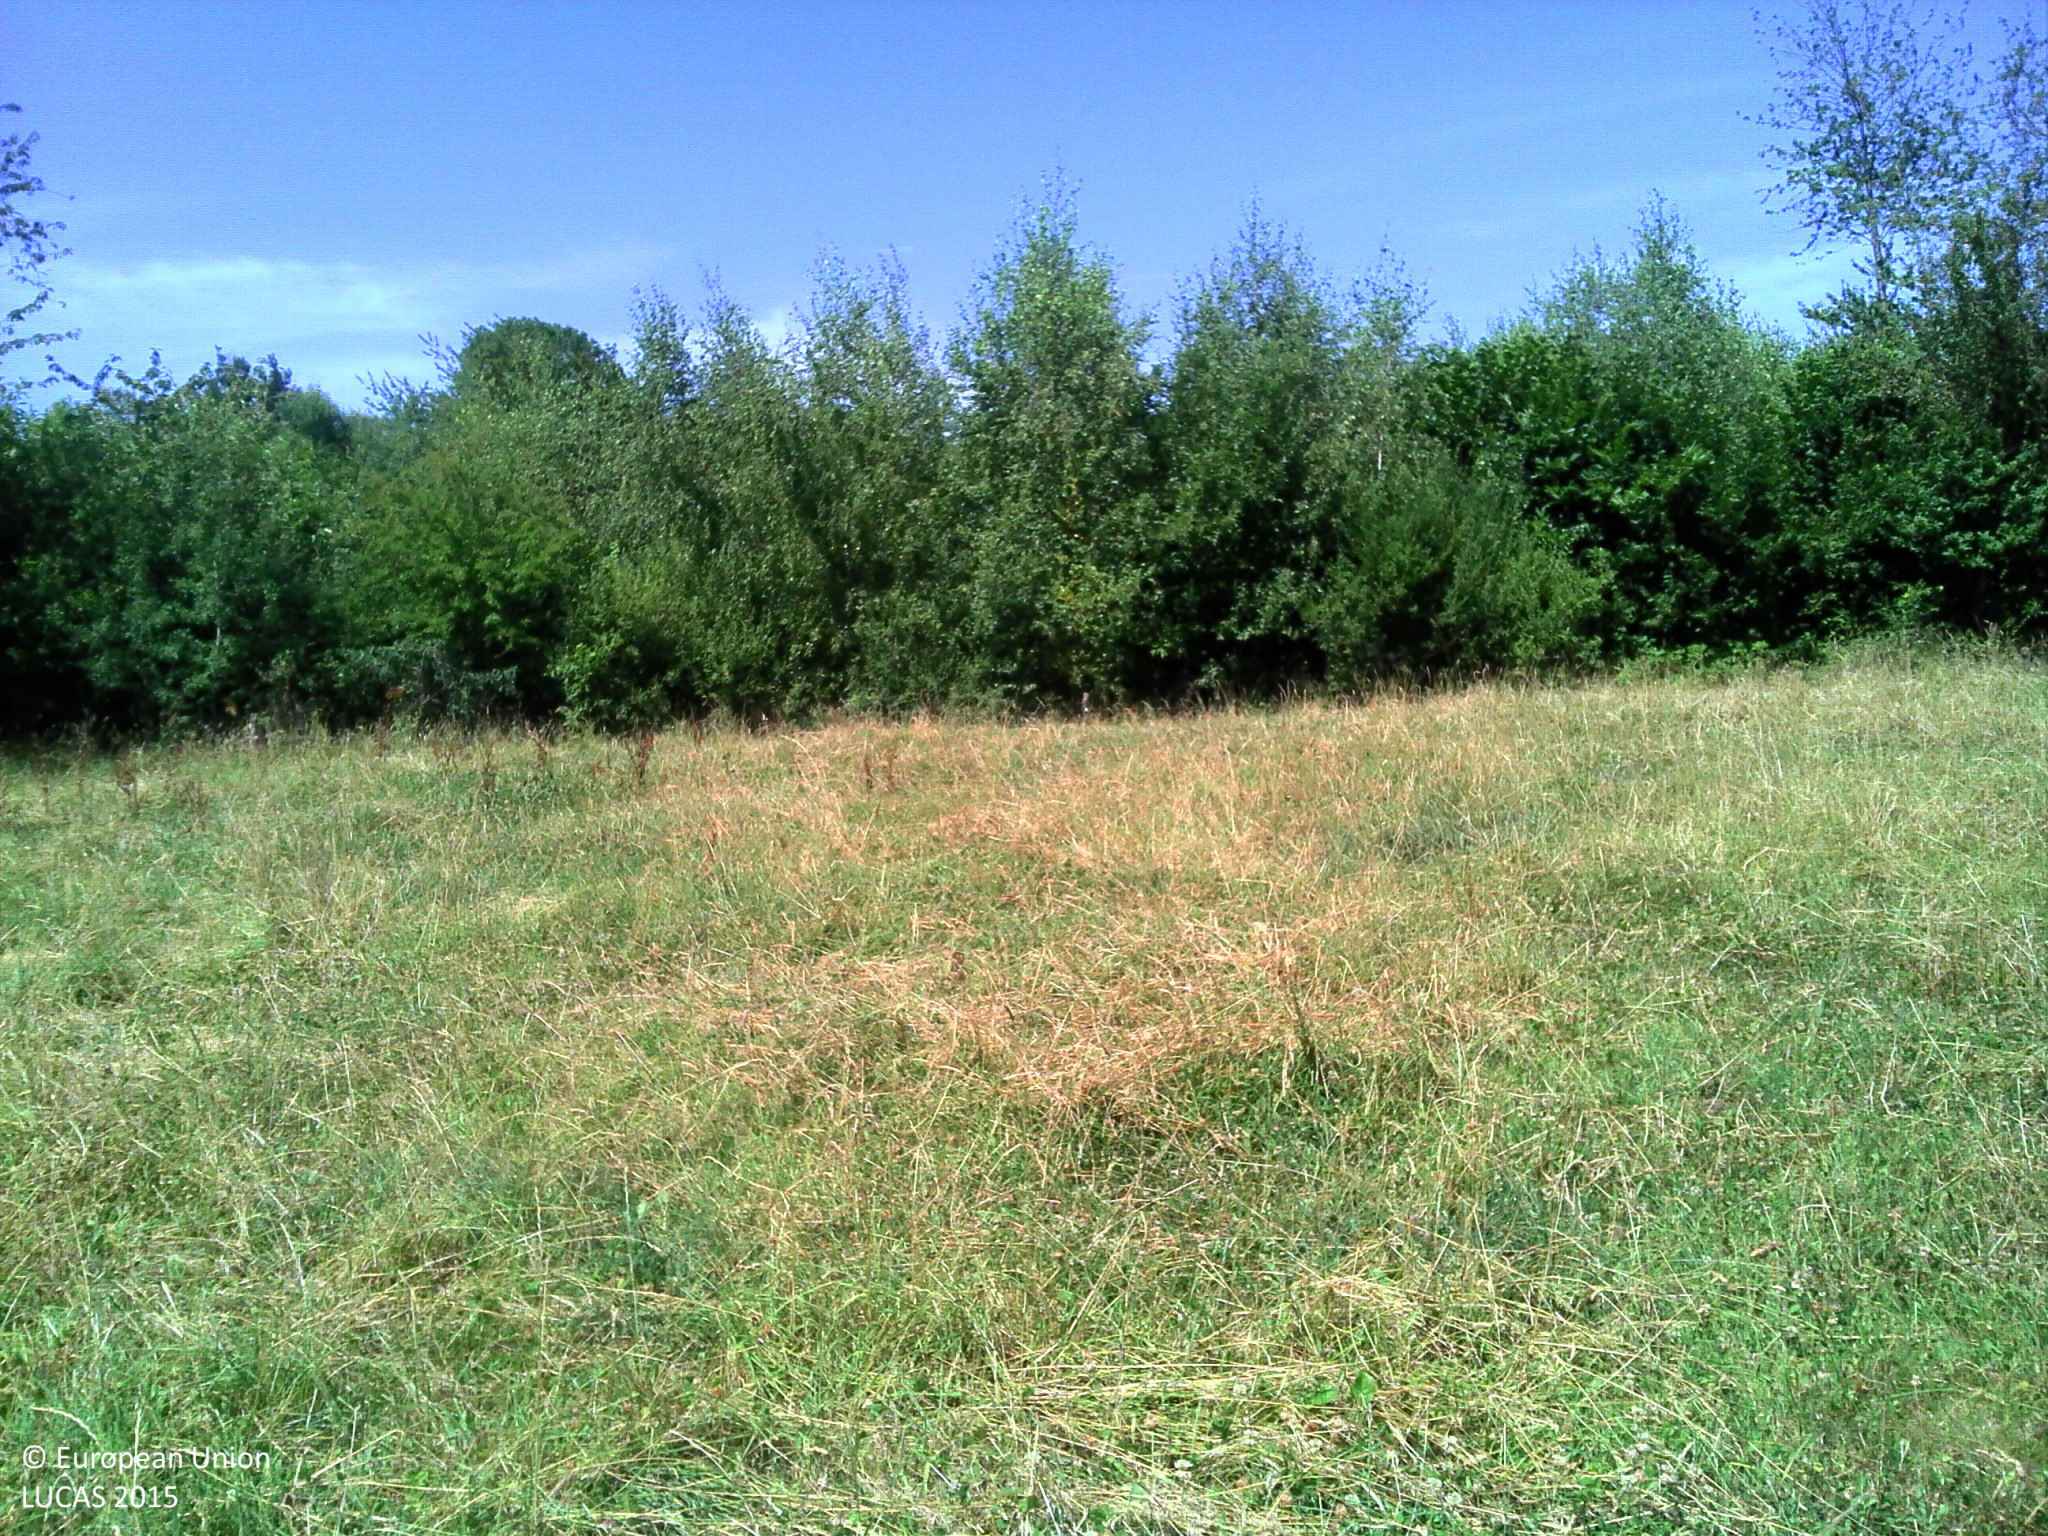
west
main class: Grassland
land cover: Grassland without tree/shrub cover
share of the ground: > 75 %
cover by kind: herbaceous plants 100 %
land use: Agriculture (excluding fallow land and kitchen gardens)
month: July
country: FR
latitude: 45.2689
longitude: 5.2000
